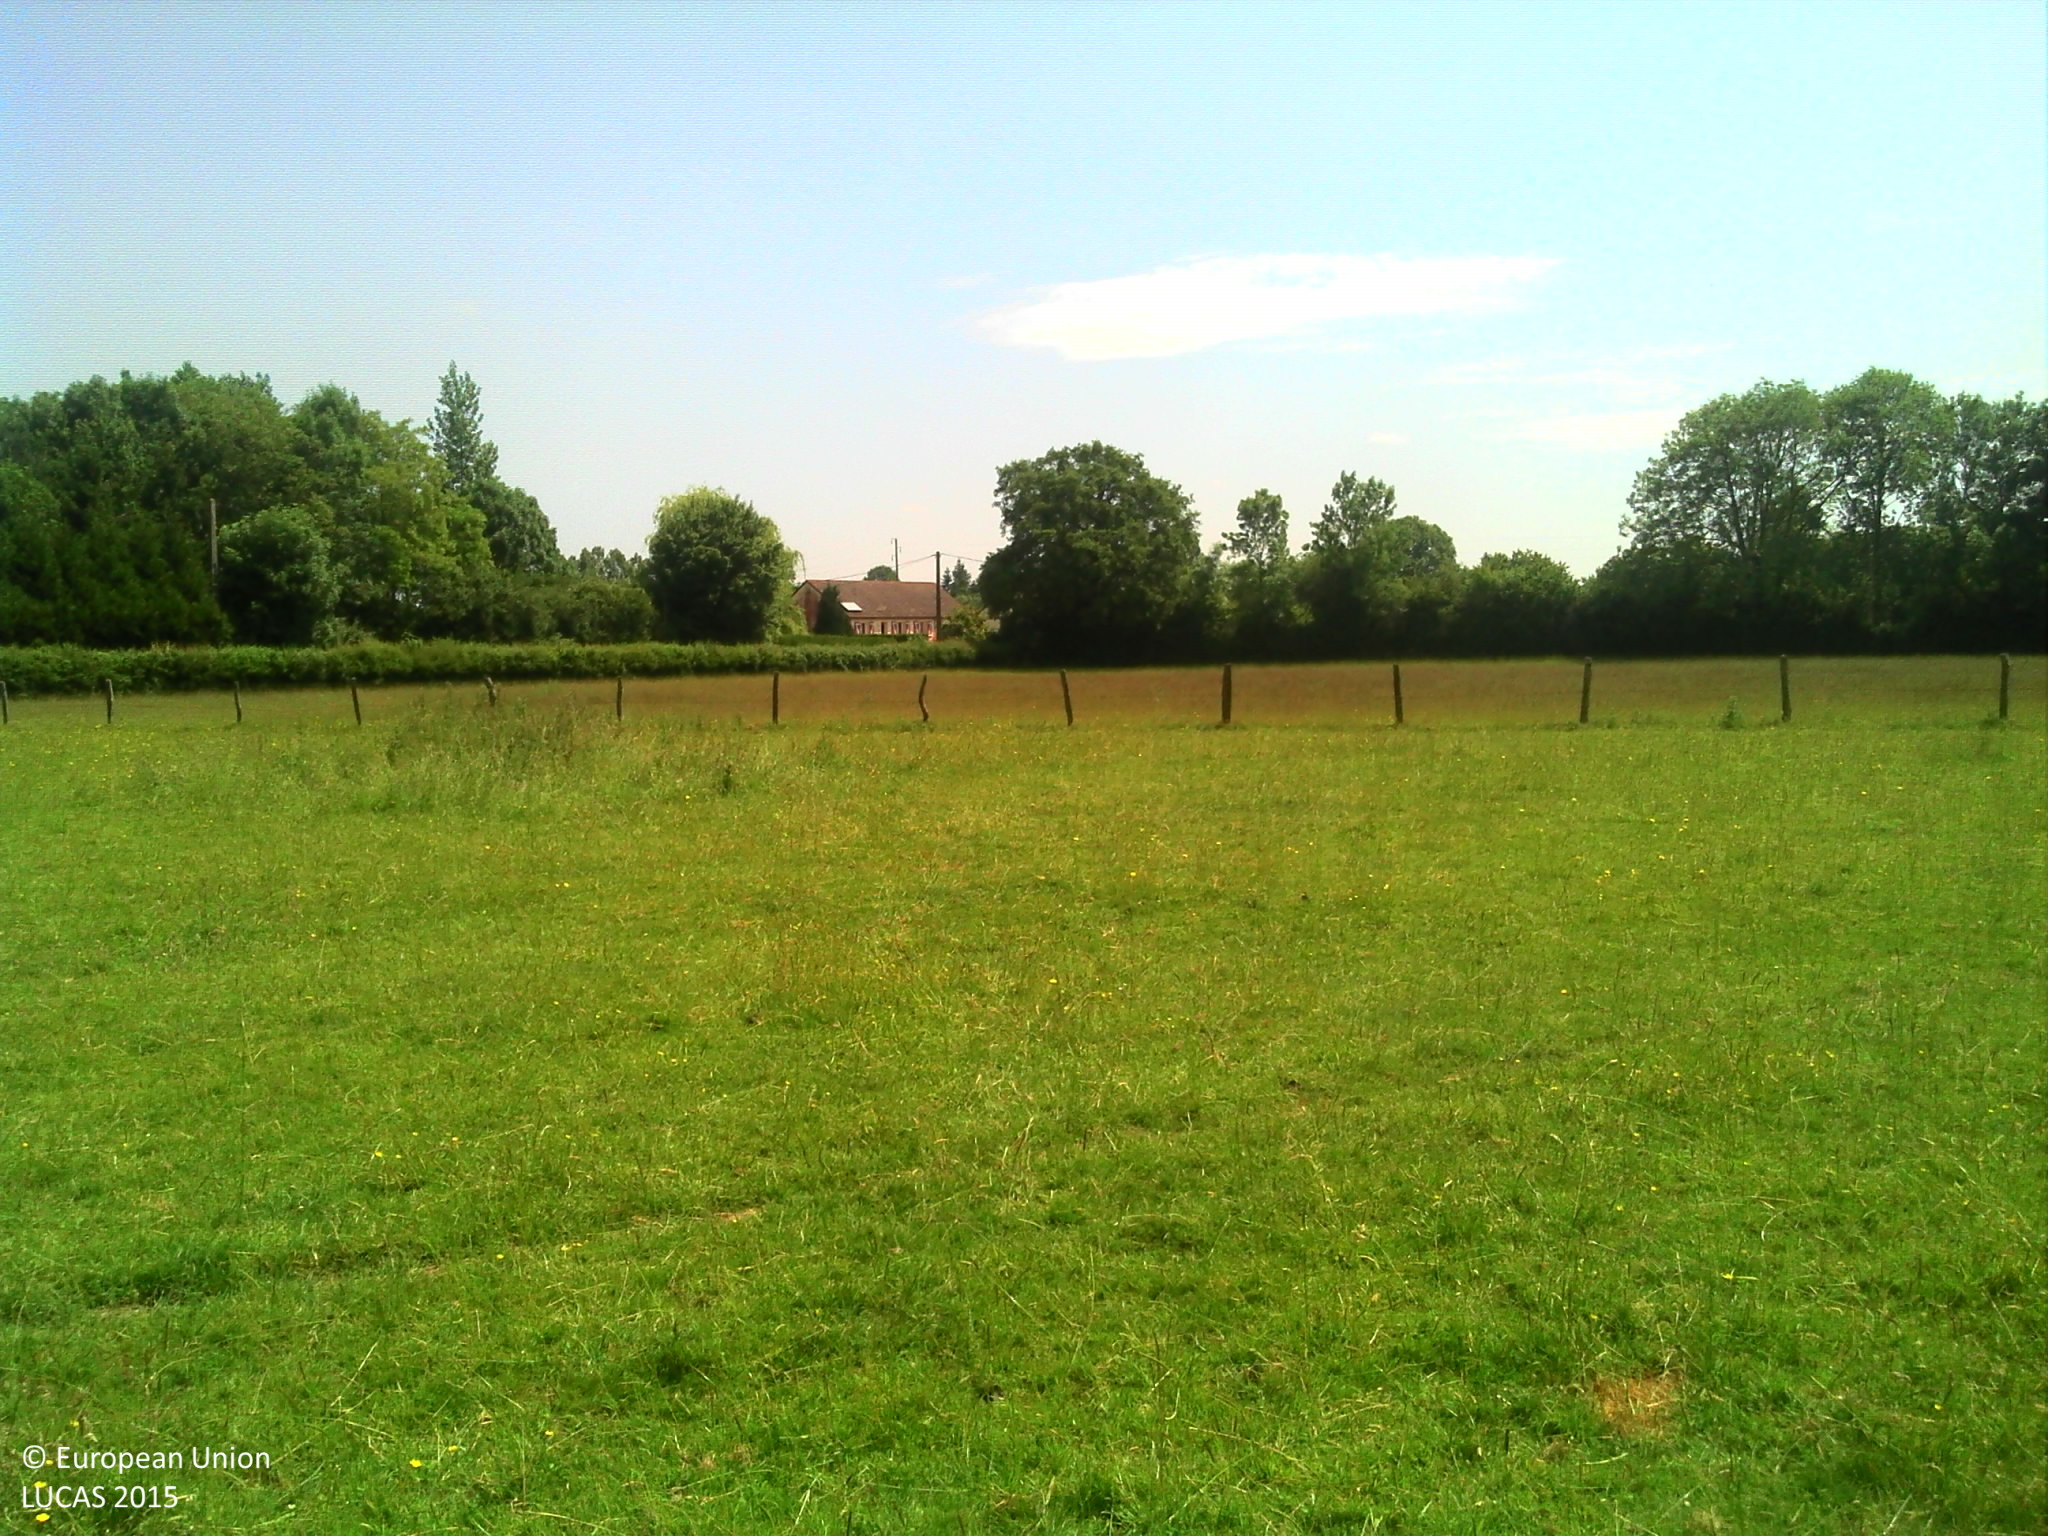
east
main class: Grassland
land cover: Grassland without tree/shrub cover
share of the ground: > 75 %
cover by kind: herbaceous plants 95 %
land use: Agriculture (excluding fallow land and kitchen gardens)
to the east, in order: Grassland without tree/shrub cover; Fences; Grassland without tree/shrub cover; Abandoned hedges; Grassland without tree/shrub cover; Electric lines; Grassland without tree/shrub cover; Electric lines; Grassland without tree/shrub cover; Abandoned hedges; Spontaneously vegetated surfaces; Abandoned hedges; Ditches and canals; Paved roads, cycling and walking lanes
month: June
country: FR
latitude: 48.5096
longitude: 0.1855
